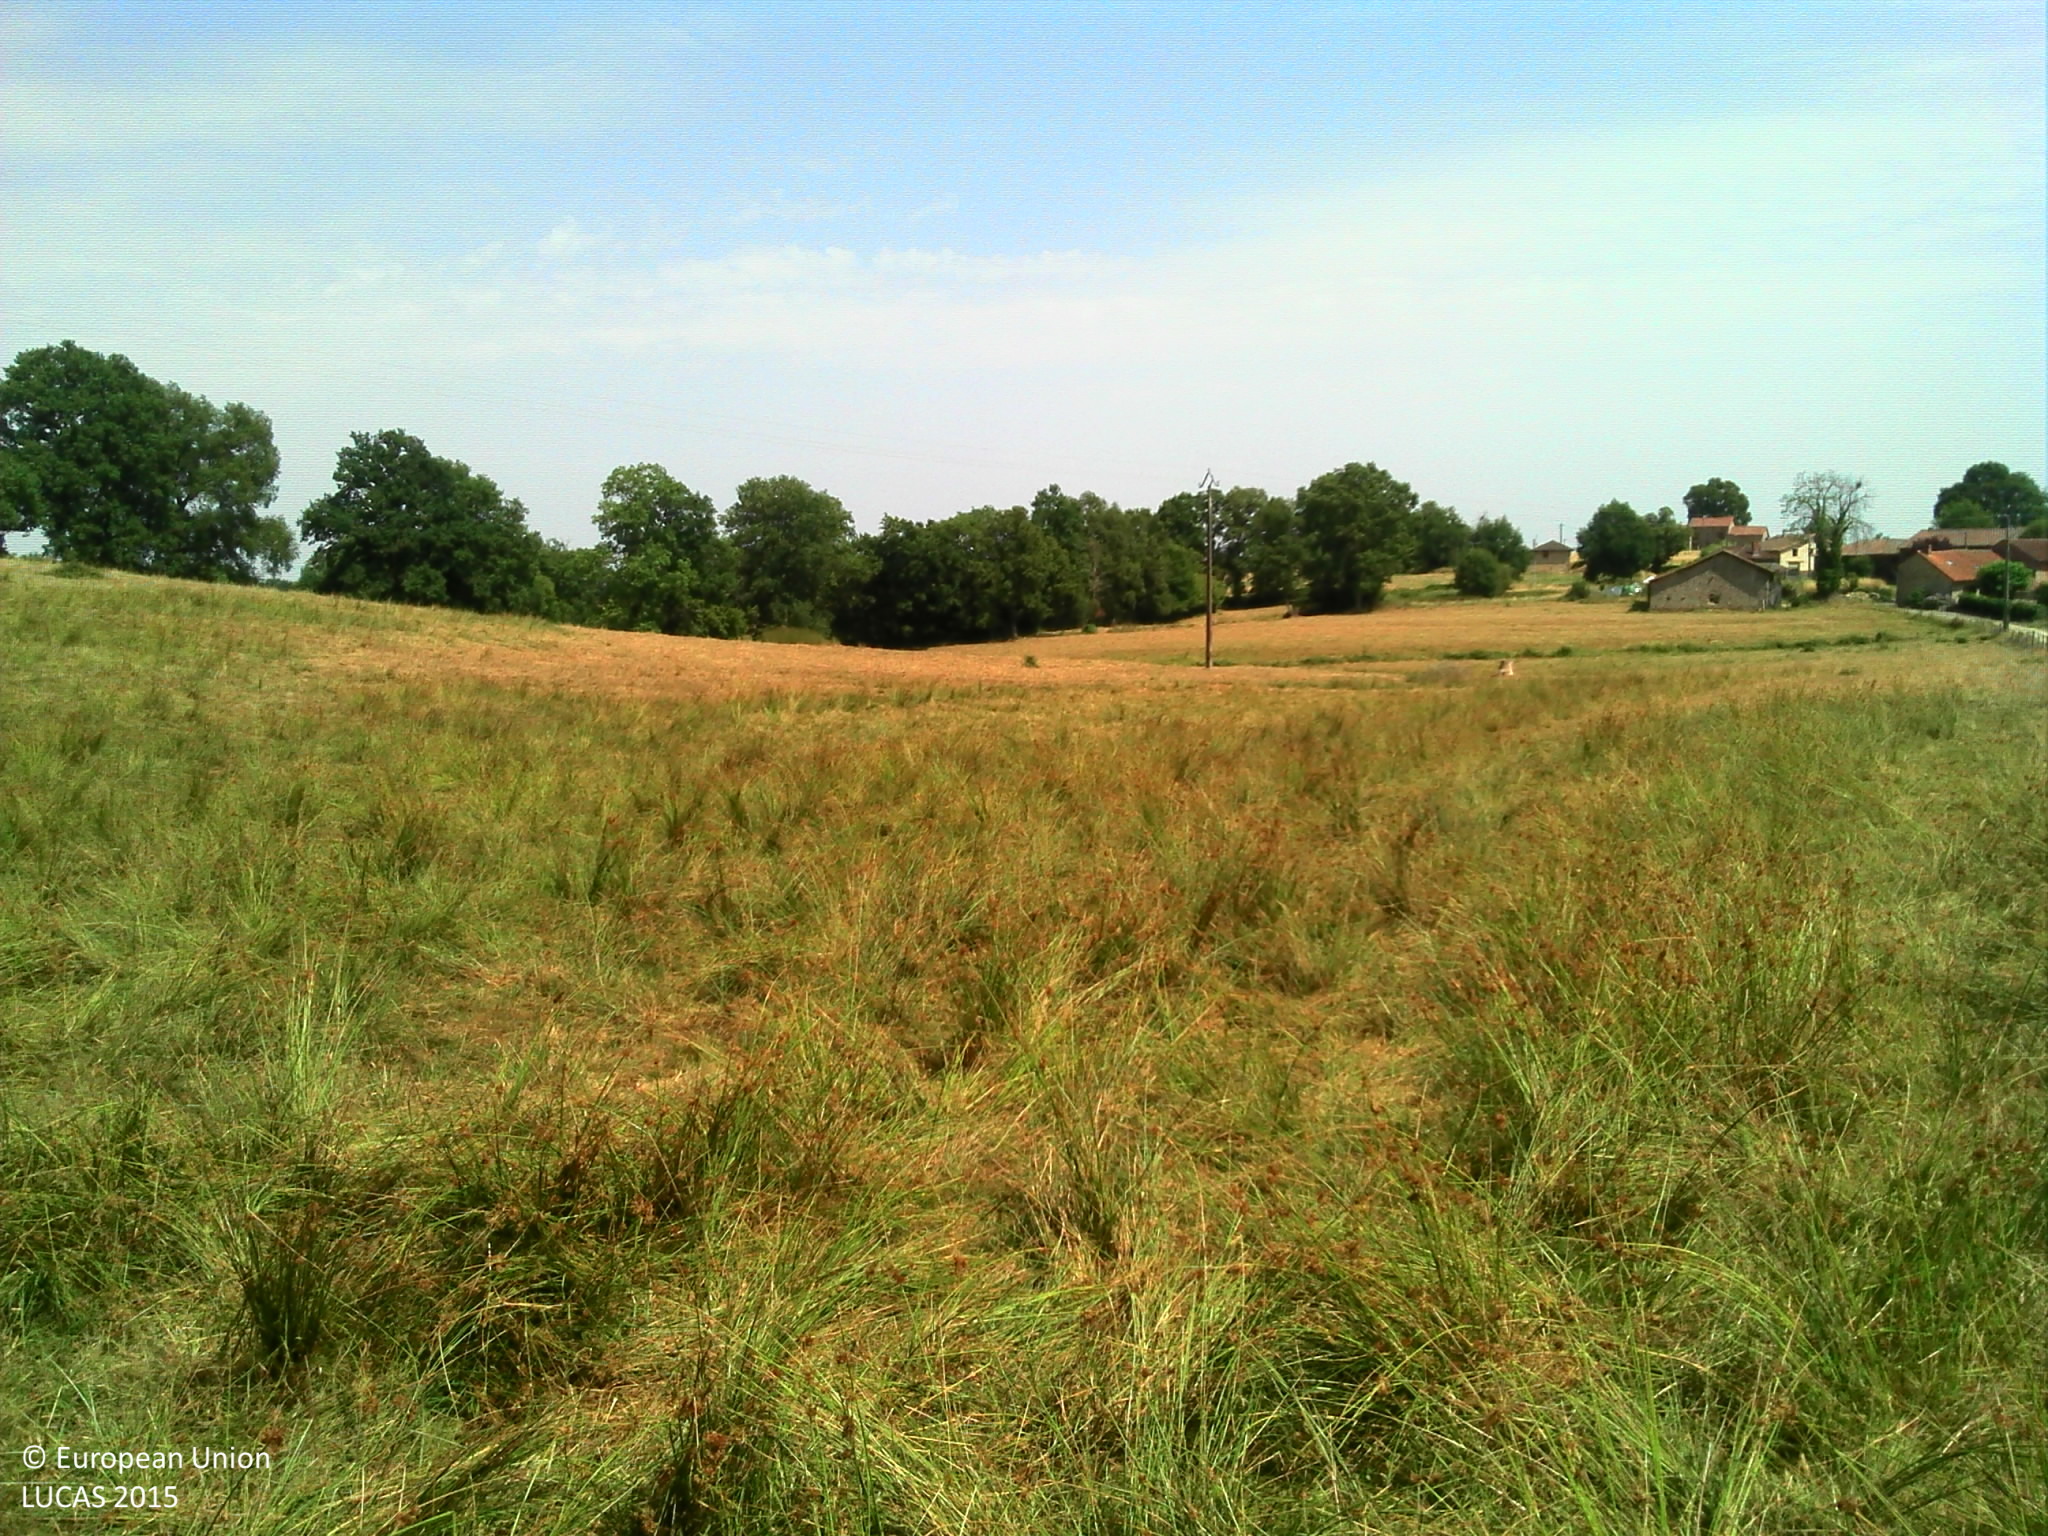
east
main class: Grassland
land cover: Grassland without tree/shrub cover
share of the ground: > 75 %
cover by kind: herbaceous plants 90 %, unconsolidated bare surface 5 %
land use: Agriculture (excluding fallow land and kitchen gardens)
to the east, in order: Grassland without tree/shrub cover; Electric lines; Grassland without tree/shrub cover; Lines of trees; Spontaneously vegetated surfaces
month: July
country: FR
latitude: 45.7562
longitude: 1.0289
